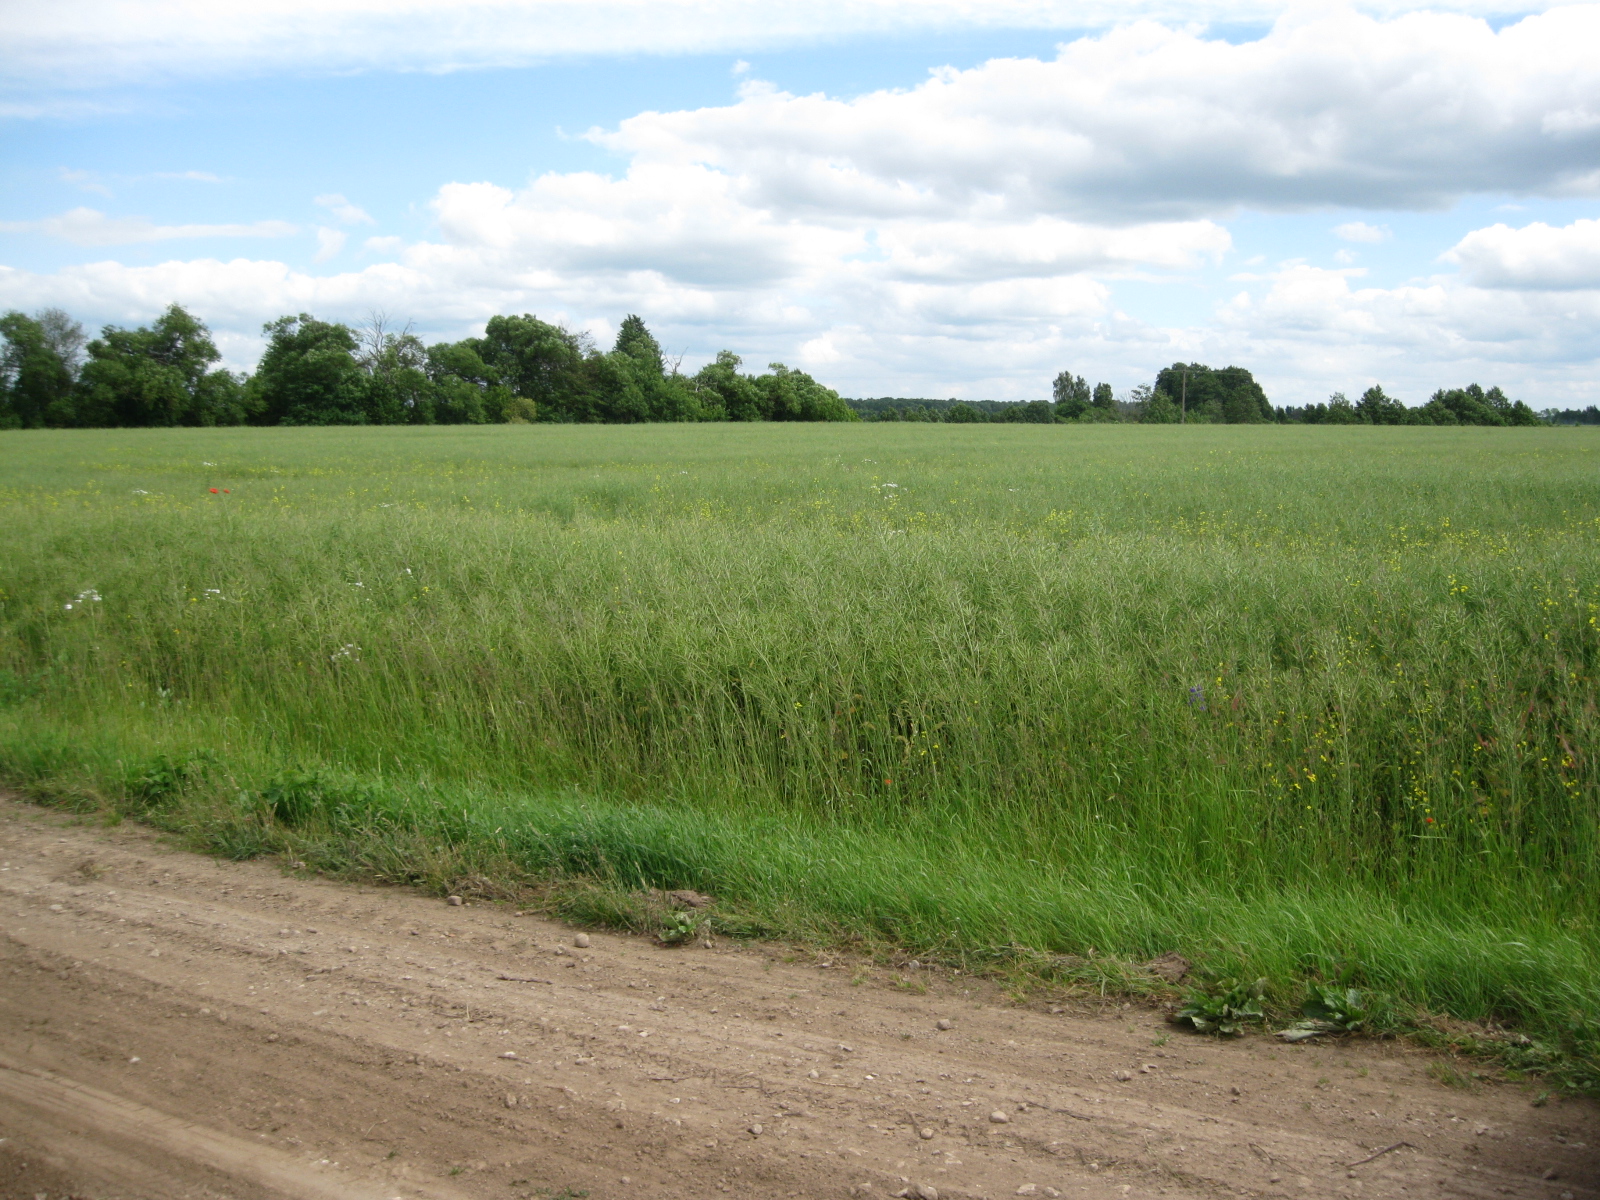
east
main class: Cropland
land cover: Rape and turnip rape
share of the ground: > 75 %
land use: Agriculture (excluding fallow land and kitchen gardens)
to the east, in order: Rape and turnip rape; Grass margins; Paved roads, cycling and walking lanes; Grass margins; Rape and turnip rape; Broadleaved woodland; Spontaneously vegetated surfaces; Rape and turnip rape; Broadleaved woodland; Electric lines; Spontaneously vegetated surfaces
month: June
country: LT
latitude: 55.6076
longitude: 24.2377
